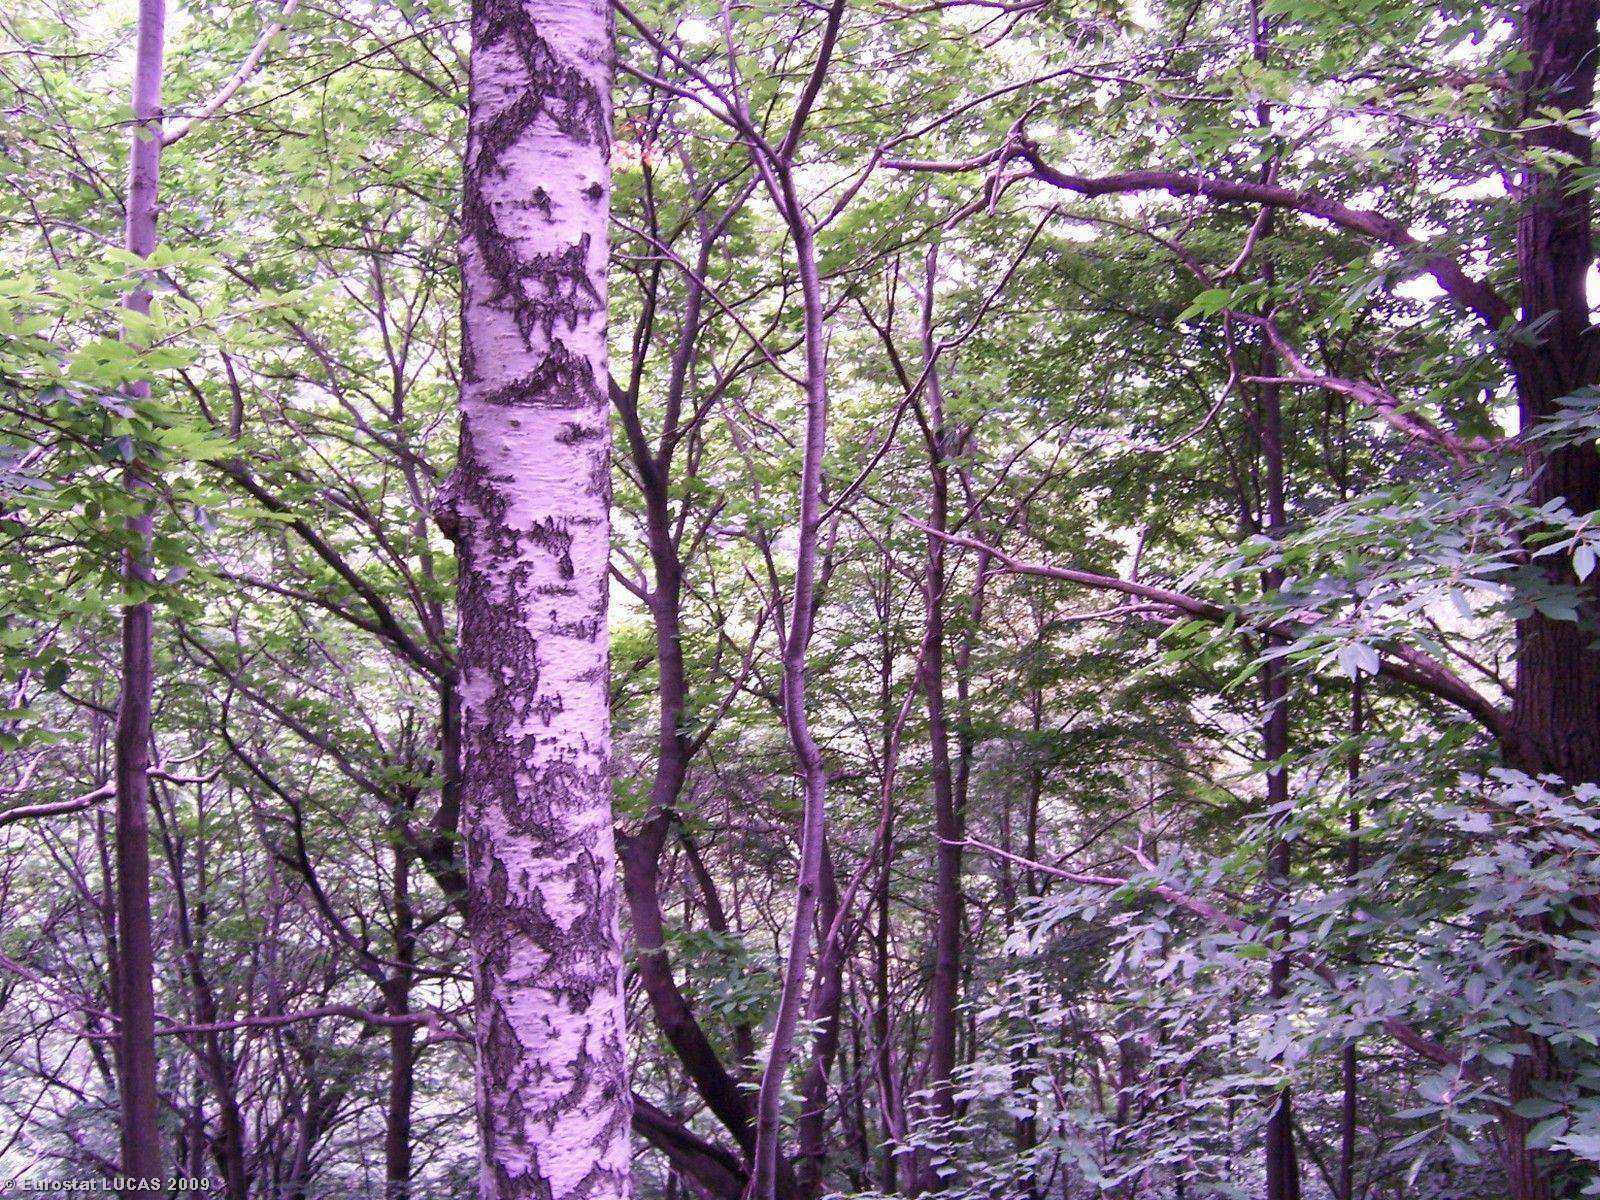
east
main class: Woodland
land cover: Broadleaved woodland
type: mesophytic deciduous forest
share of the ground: > 75 %
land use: Forestry
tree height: > 5 m
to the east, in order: Broadleaved woodland; Inland running water; Broadleaved woodland
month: July
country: IT
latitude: 45.1651
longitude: 7.3708
